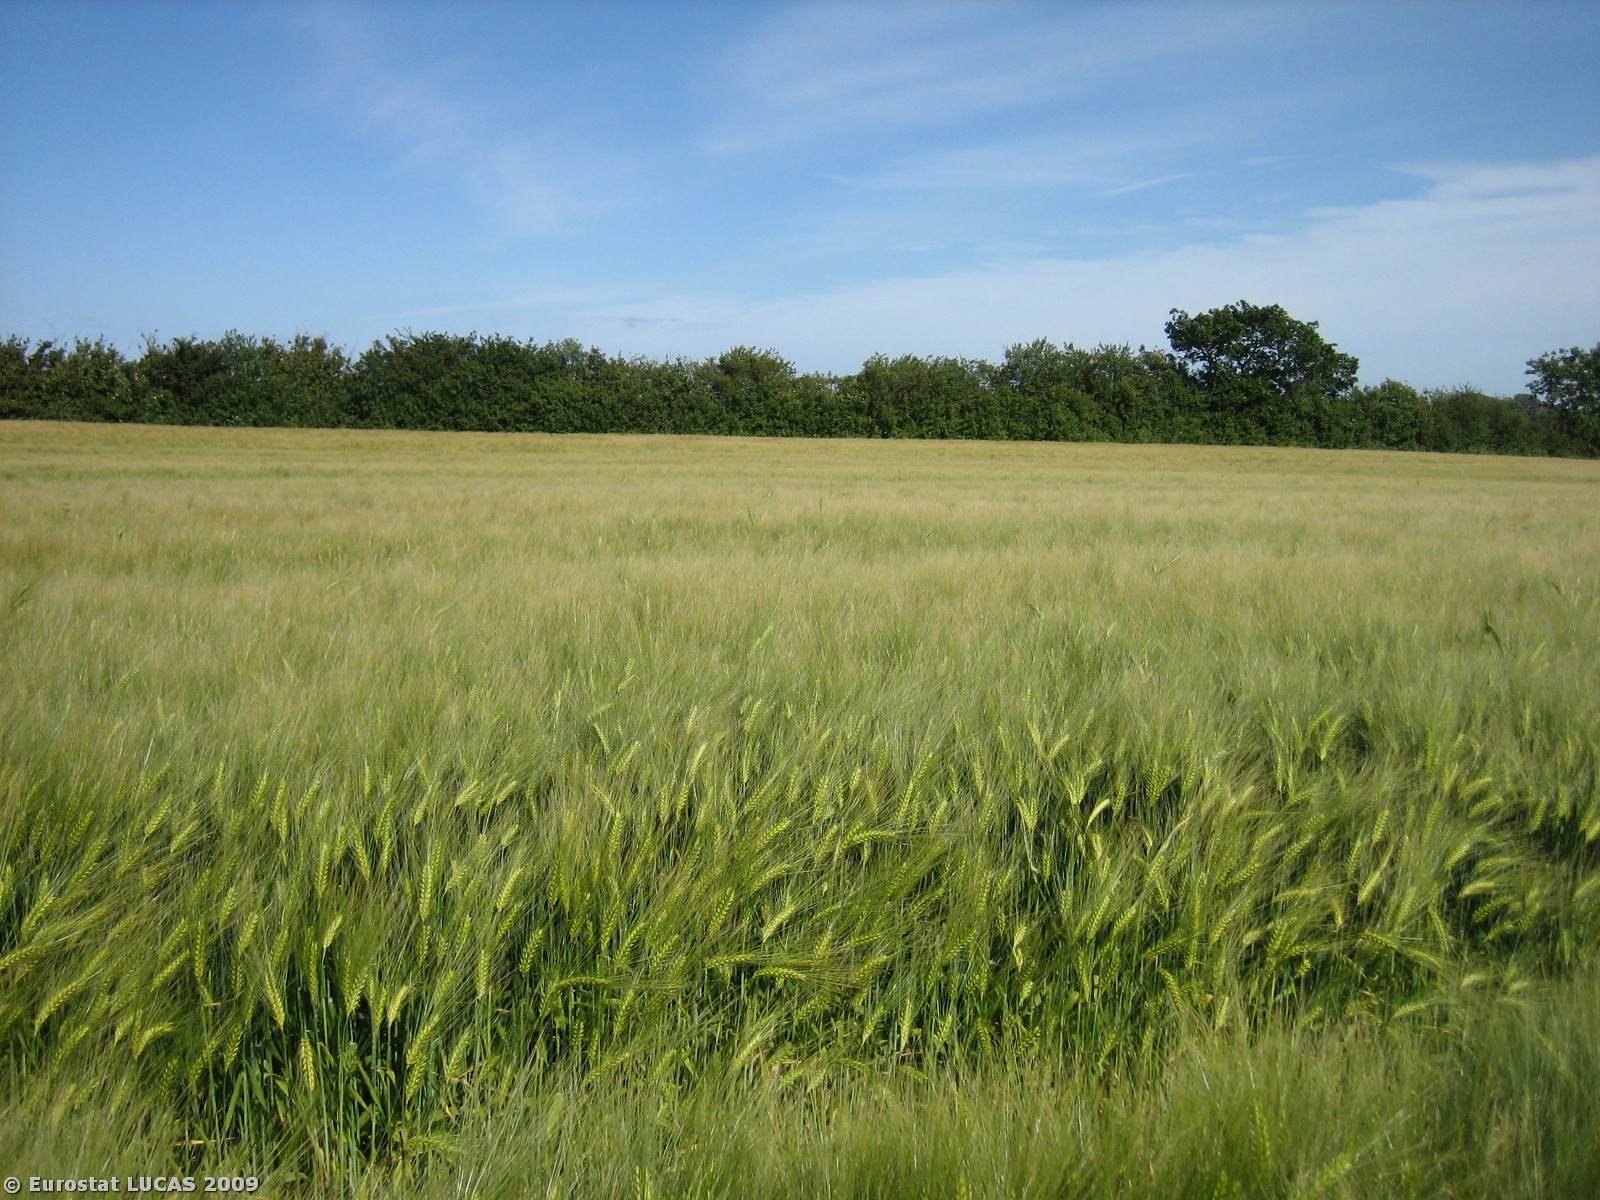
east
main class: Cropland
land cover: Barley
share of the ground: > 75 %
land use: Agriculture (excluding fallow land and kitchen gardens)
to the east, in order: Barley; Shrubland with sparse tree cover; Barley
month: June
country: DK
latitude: 55.7203
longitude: 9.8569
